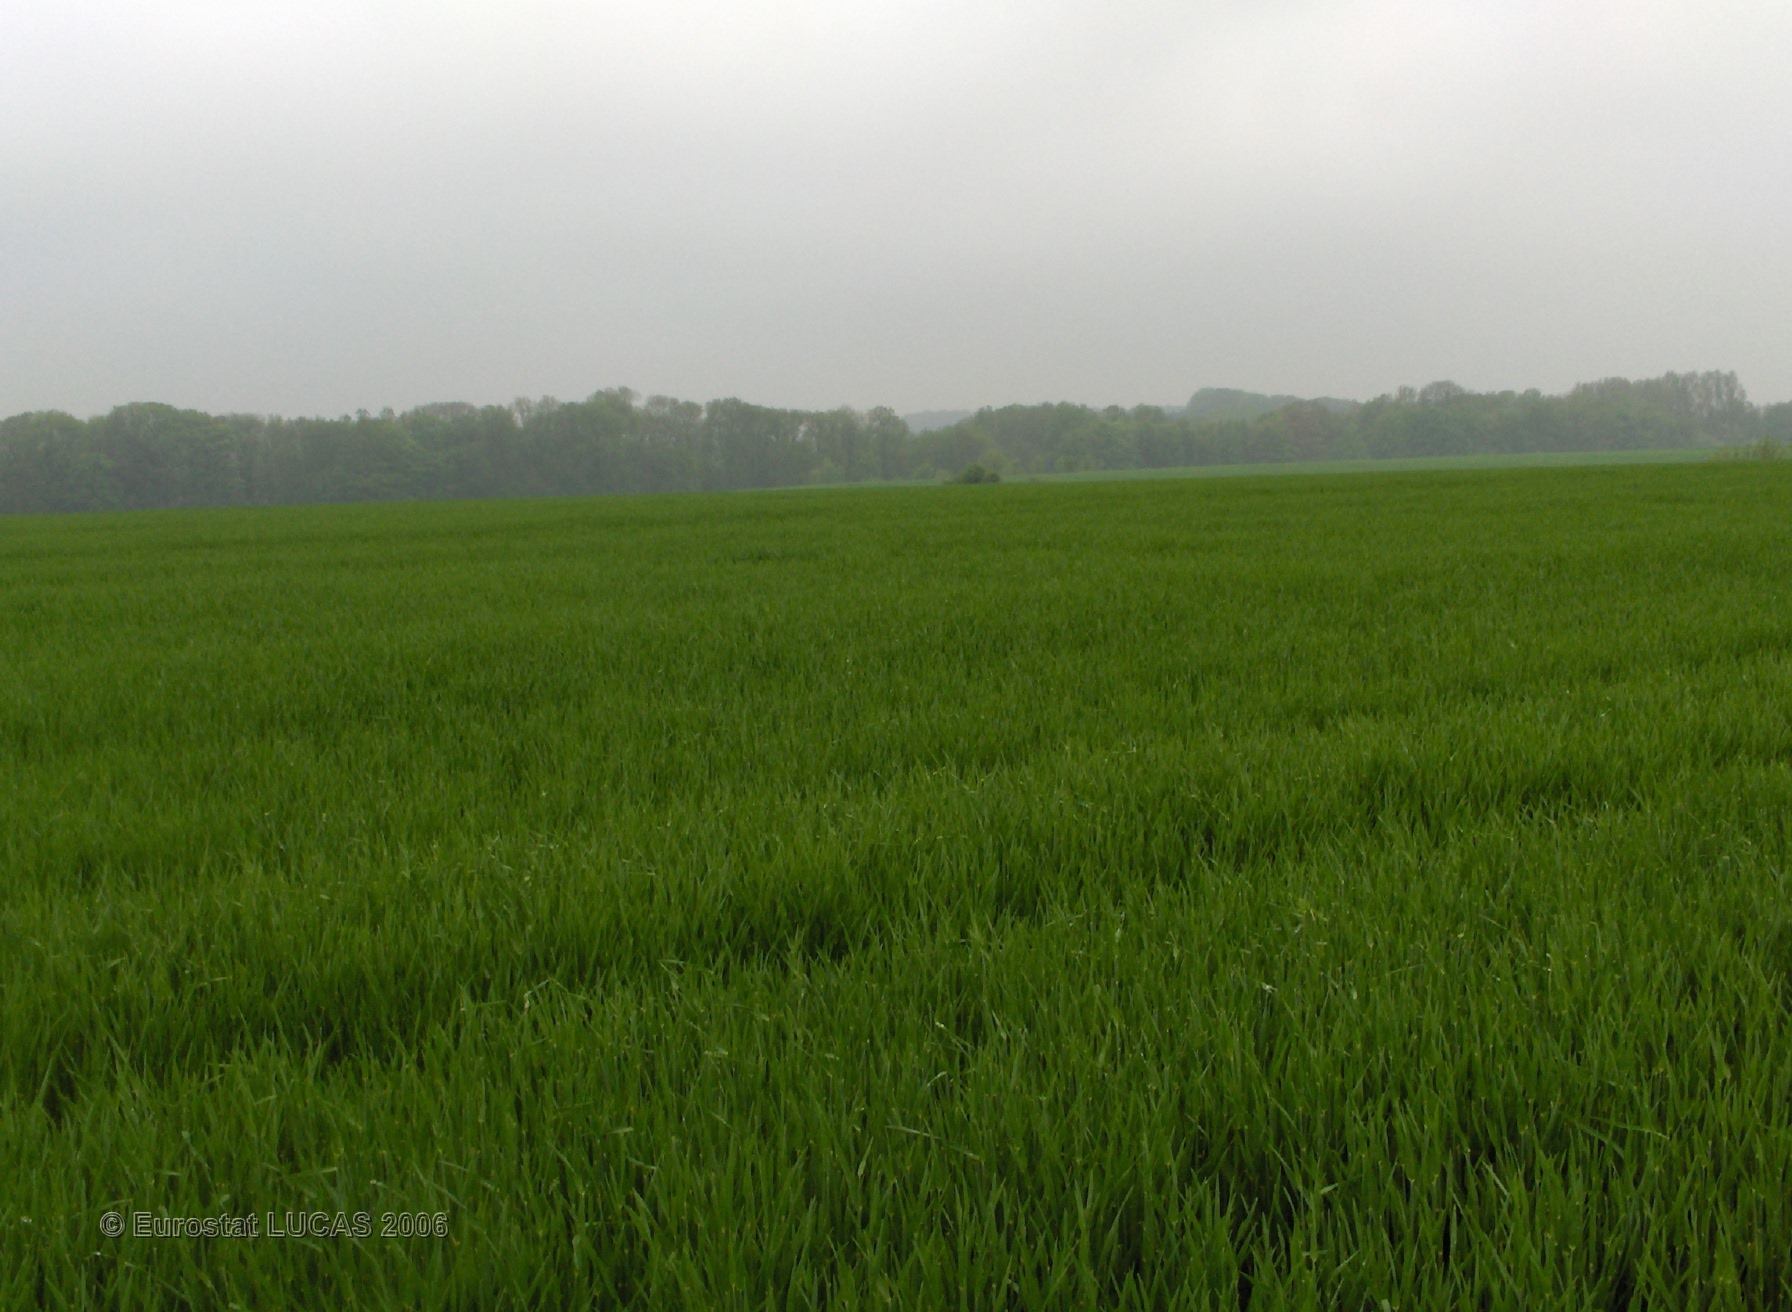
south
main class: Cropland
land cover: Common wheat
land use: Agriculture (excluding fallow land and kitchen gardens)
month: May
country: BE
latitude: 50.5551
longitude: 4.4769
